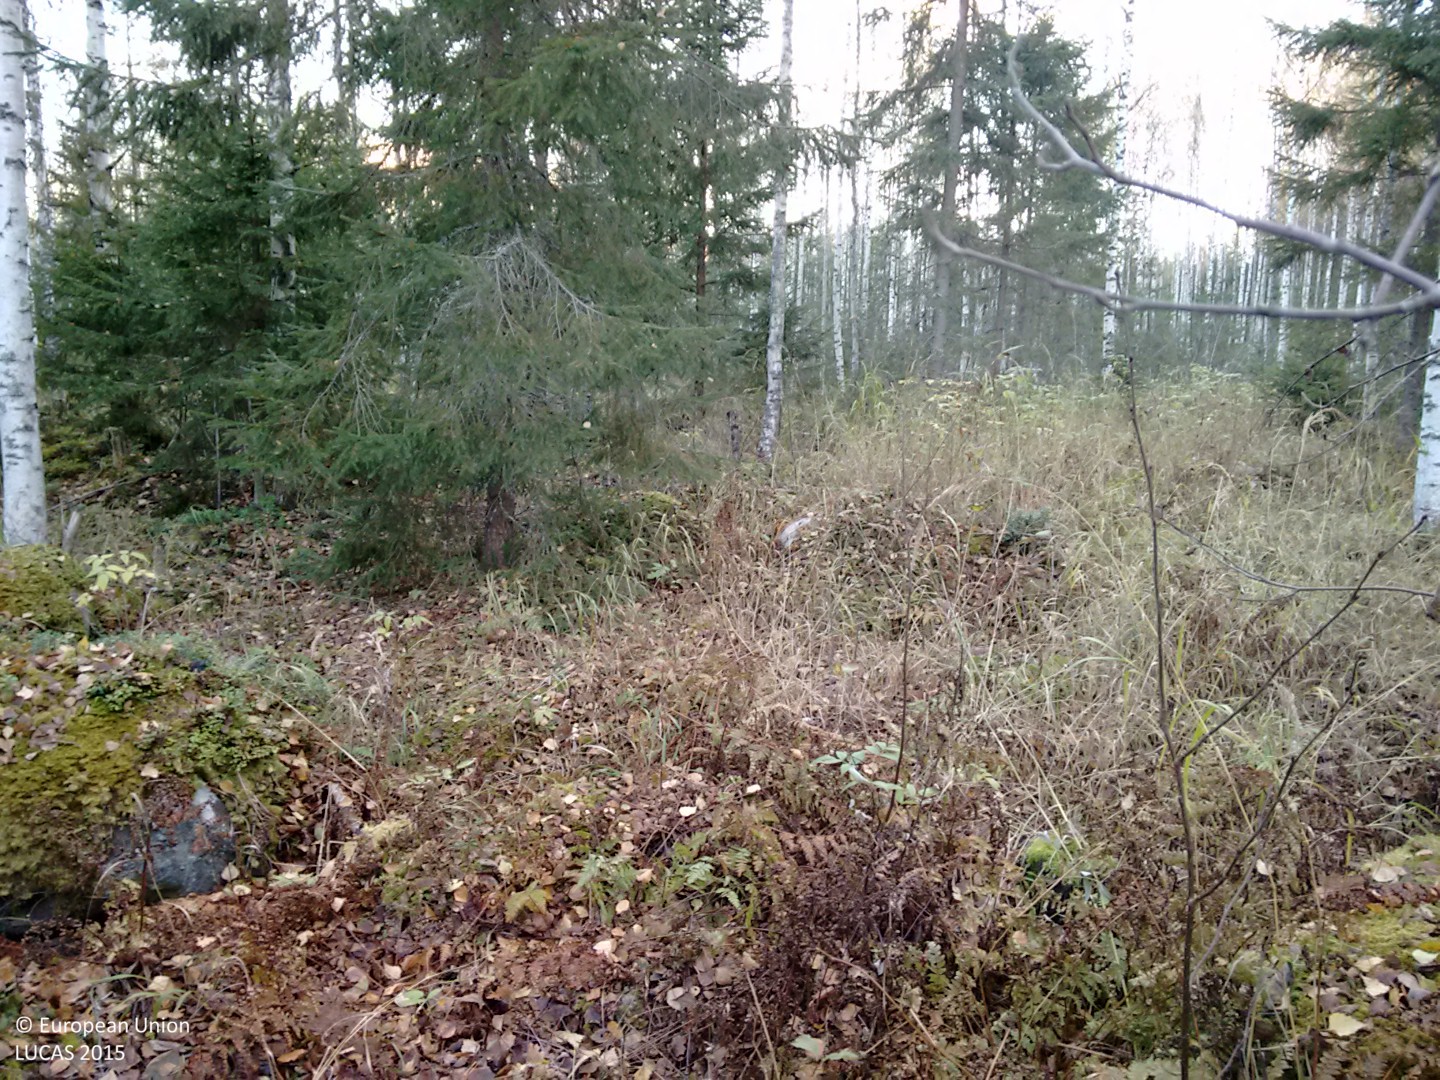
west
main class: Woodland
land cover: Spruce dominated mixed woodland
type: boreal forest
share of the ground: > 75 %
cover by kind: broadleaved forest trees 45 %, coniferous forest trees 40 %, shrubs 10 %, herbaceous plants 5 %
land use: Forestry
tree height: > 5 m
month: October
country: FI
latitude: 62.8430
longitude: 26.1292
